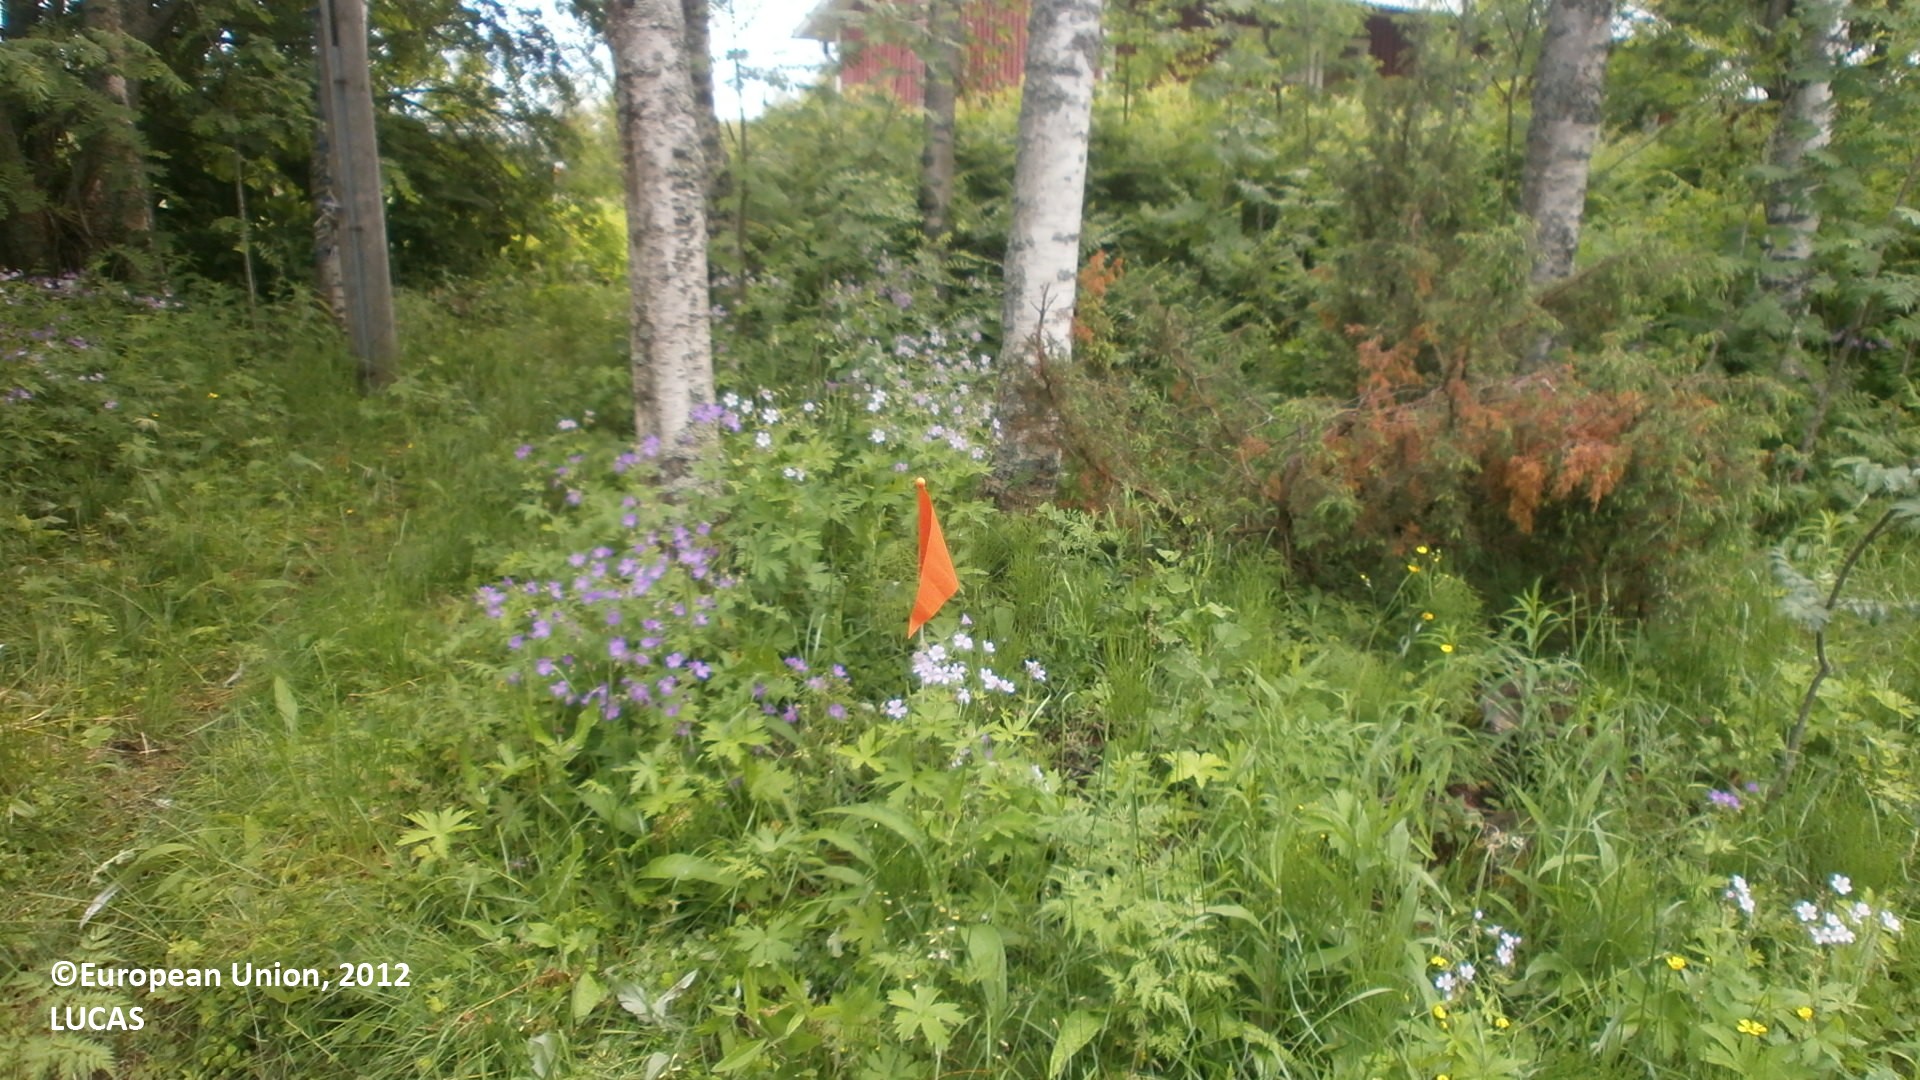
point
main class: Woodland
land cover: Broadleaved woodland
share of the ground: 50 - 75 %
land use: Residential
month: June
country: FI
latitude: 64.2984
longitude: 24.8971
